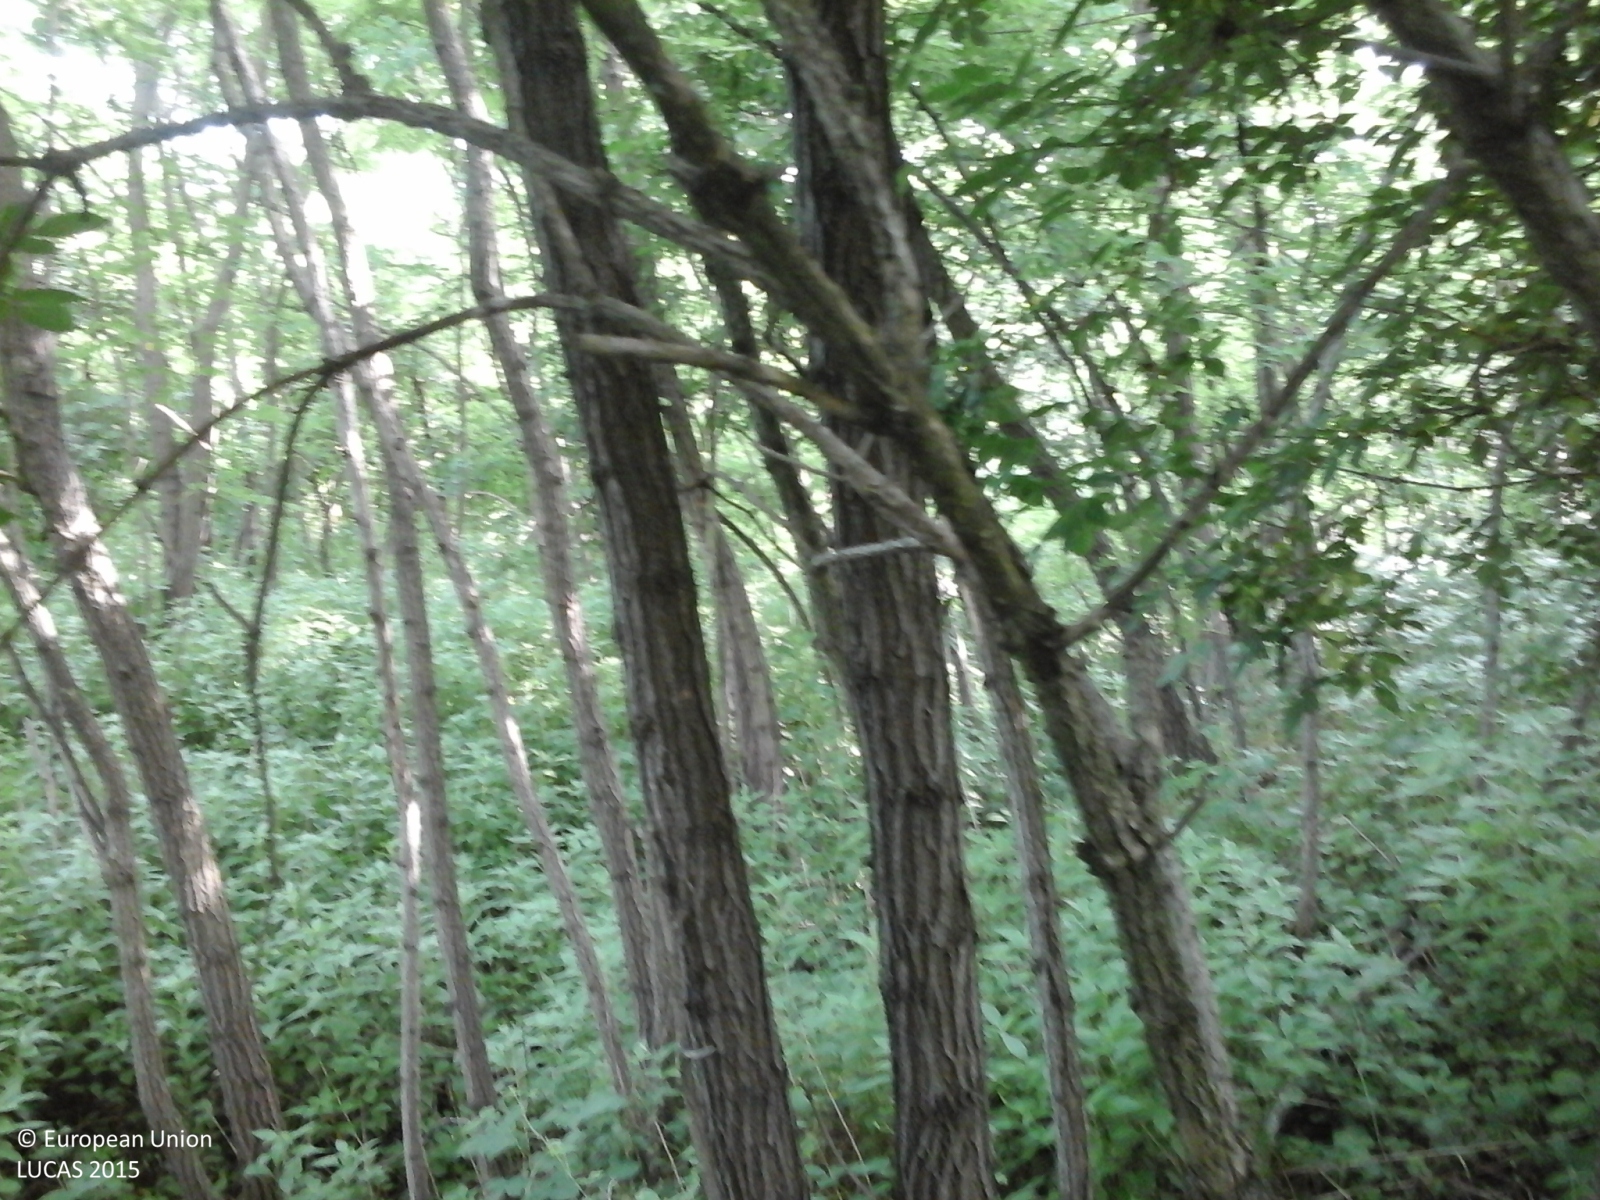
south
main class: Woodland
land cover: Broadleaved woodland
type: thermophilous deciduous forest
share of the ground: > 75 %
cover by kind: broadleaved forest trees 100 %
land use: Forestry
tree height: > 5 m
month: June
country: IT
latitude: 45.3792
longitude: 8.1004
